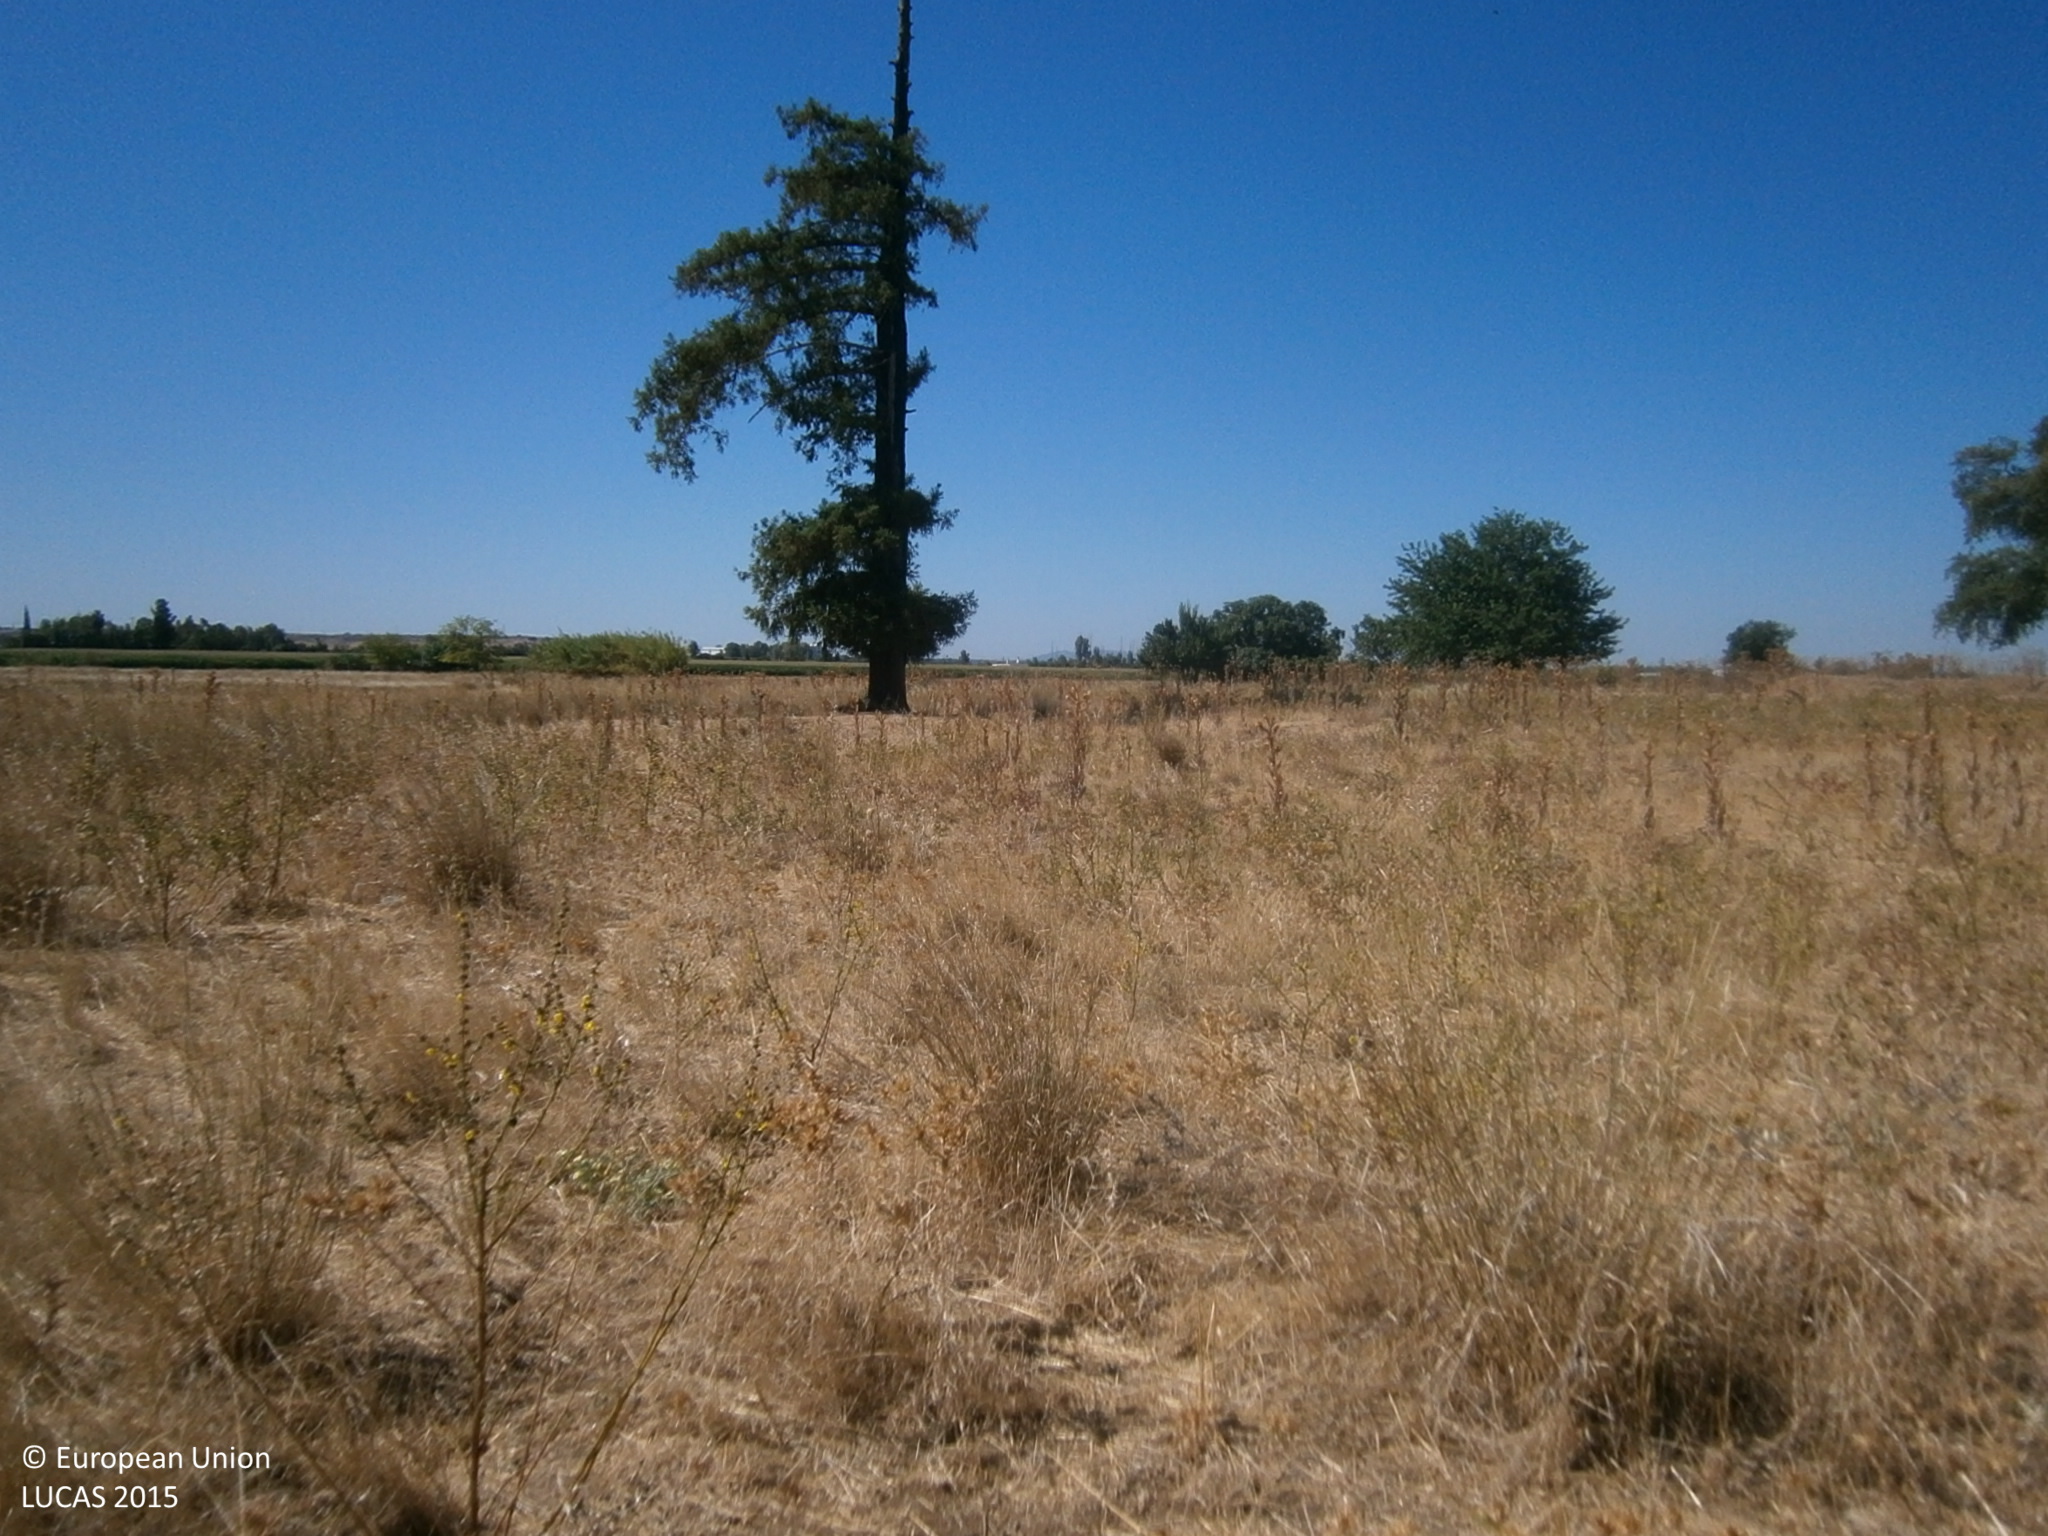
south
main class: Grassland
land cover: Grassland with sparse tree/shrub cover
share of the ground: > 75 %
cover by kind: herbaceous plants 90 %, coniferous forest trees 5 %, shrubs 5 %
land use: Agriculture (excluding fallow land and kitchen gardens)
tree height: > 5 m
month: July
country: ES
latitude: 38.8813
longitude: -7.0044
